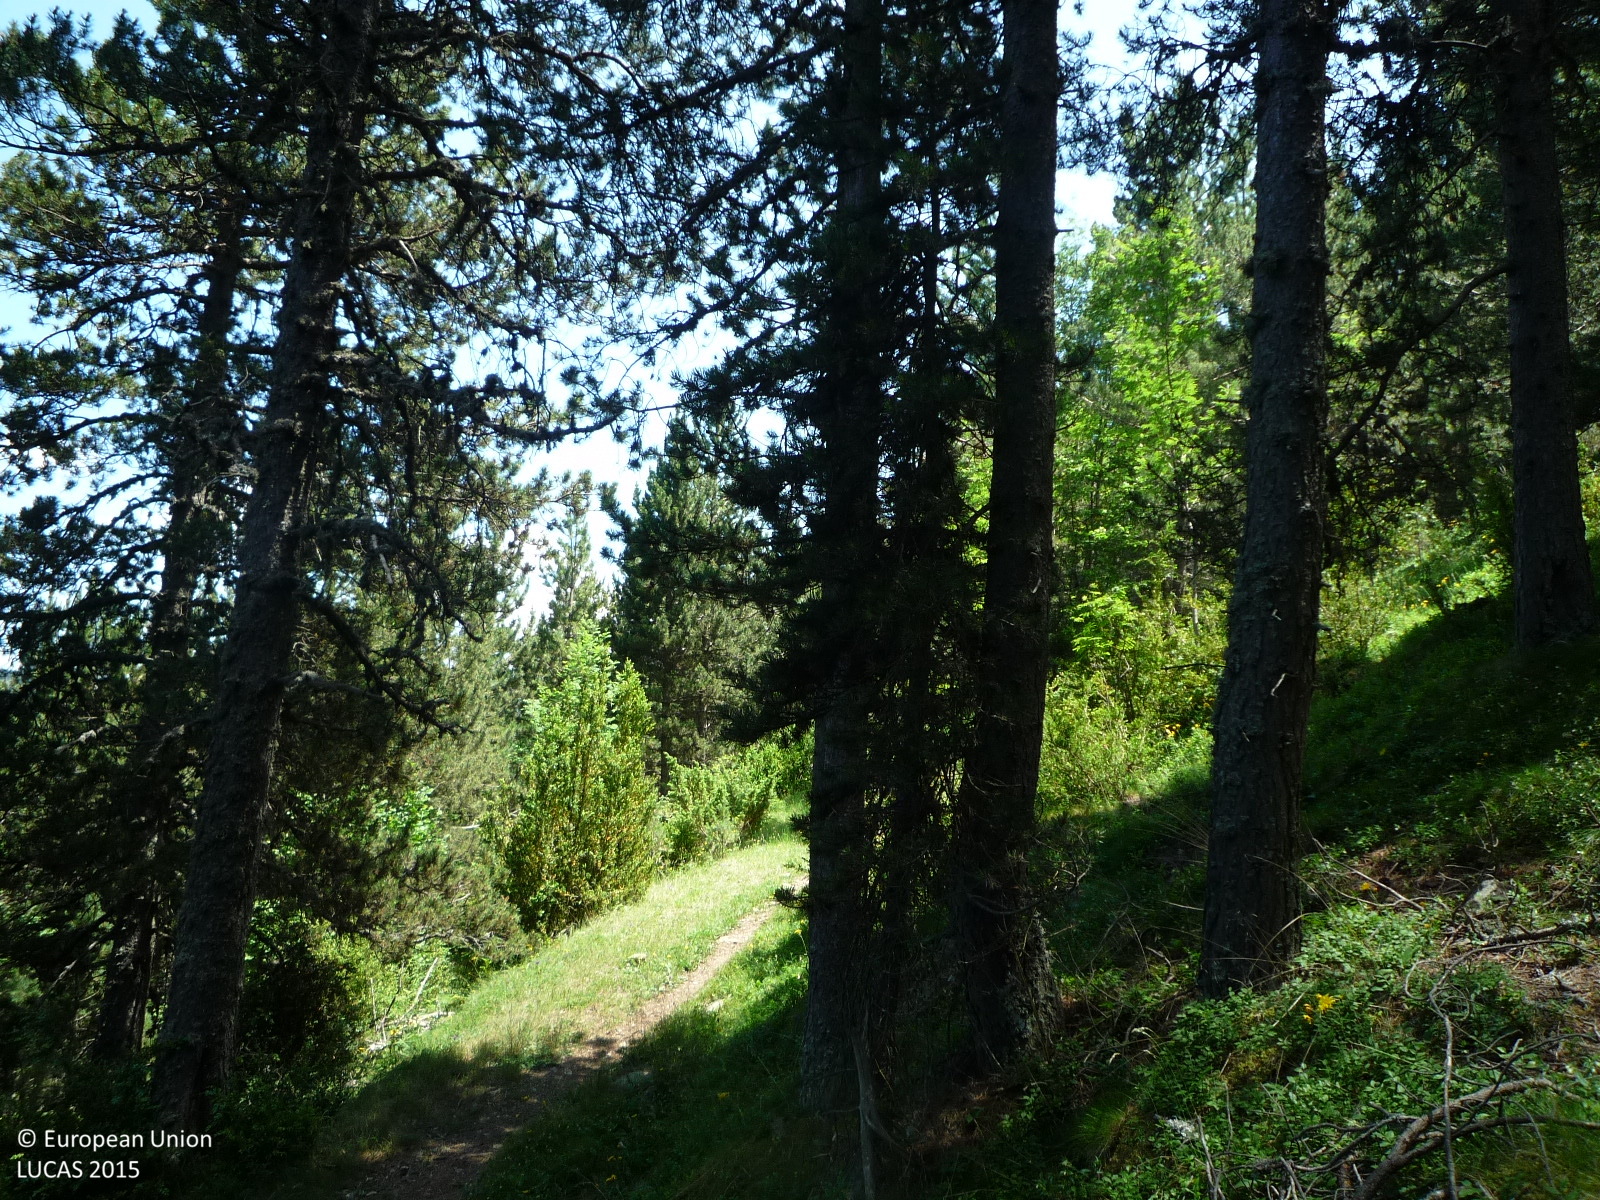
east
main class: Woodland
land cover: Pine dominated coniferous woodland
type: alpine coniferous forest
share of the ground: > 75 %
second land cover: Grassland without tree/shrub cover
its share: 10 - 25 %
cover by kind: coniferous forest trees 90 %, herbaceous plants 10 %
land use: Forestry
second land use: Agriculture (excluding fallow land and kitchen gardens)
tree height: > 5 m
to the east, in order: Pine dominated coniferous woodland; Grassland without tree/shrub cover; Tracks; Pine dominated coniferous woodland; Grassland without tree/shrub cover; Pine dominated coniferous woodland
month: June
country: ES
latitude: 42.3485
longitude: 1.9147
